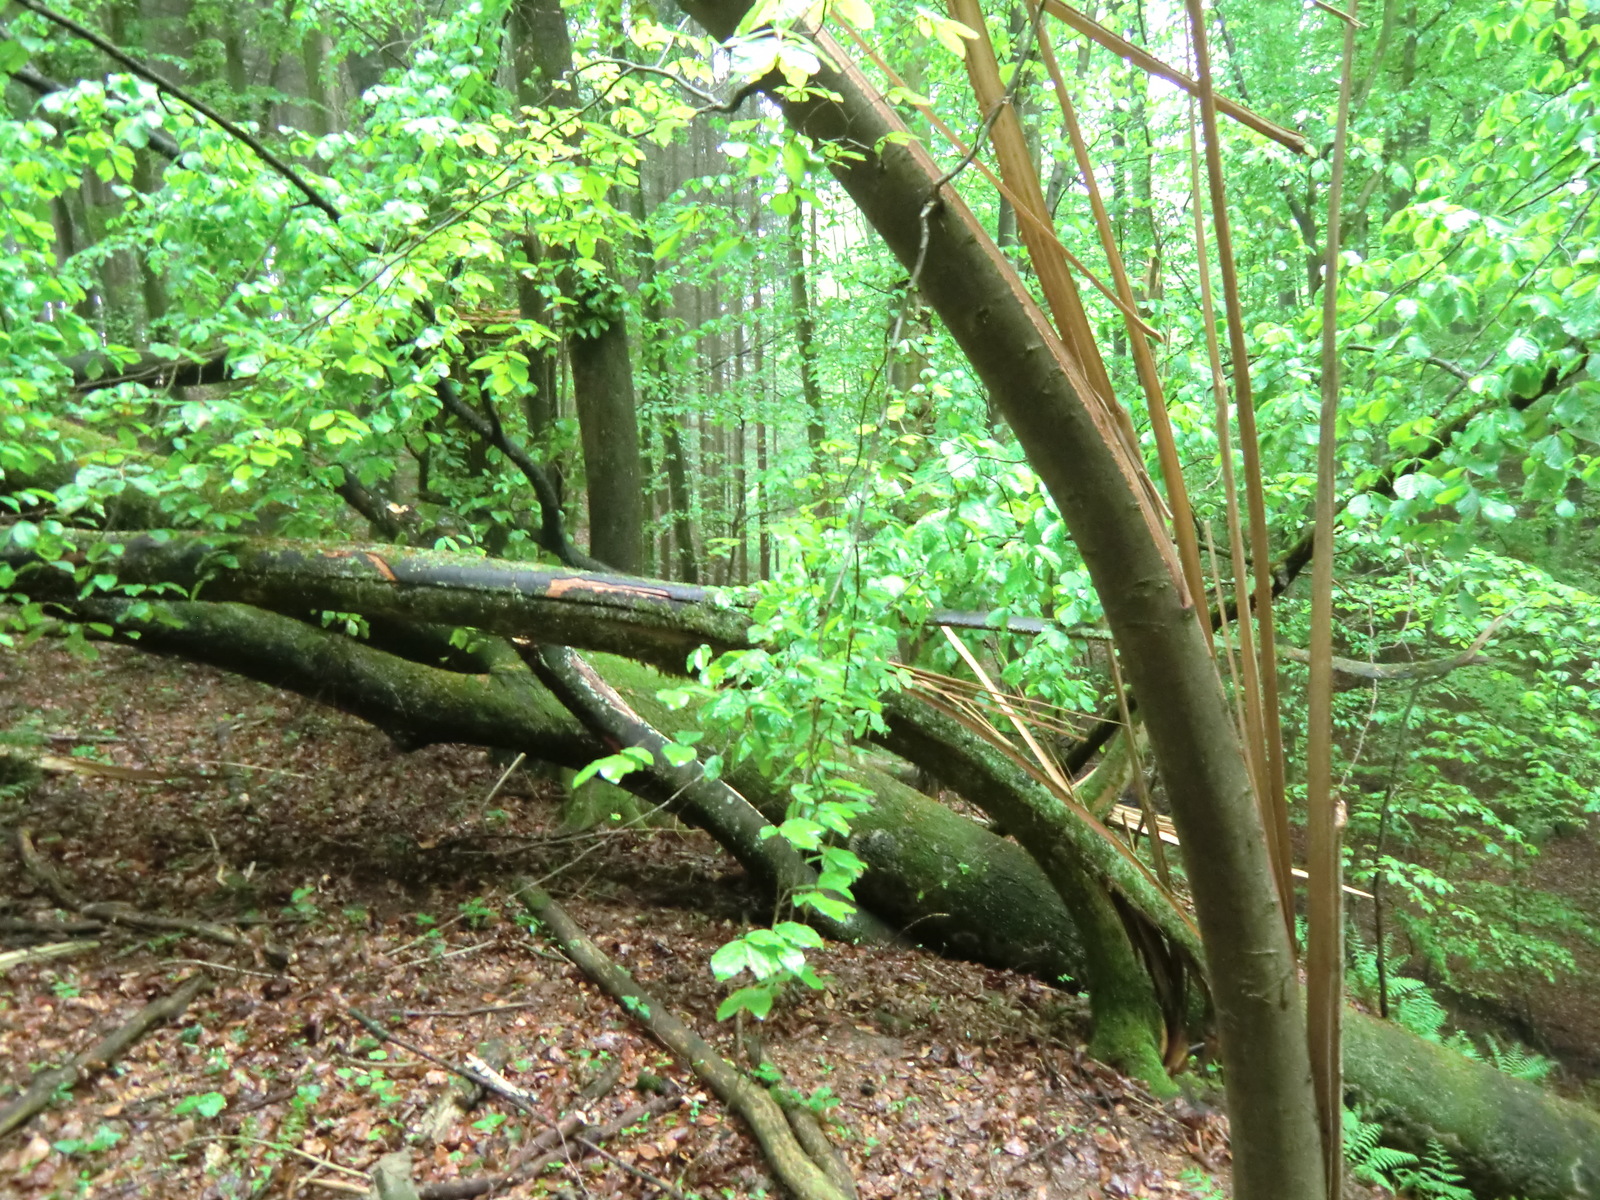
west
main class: Woodland
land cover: Broadleaved woodland
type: beech forest
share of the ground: > 75 %
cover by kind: broadleaved forest trees 80 %, unconsolidated bare surface 15 %, herbaceous plants 5 %
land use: Forestry
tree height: > 5 m
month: May
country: AT
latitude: 48.2292
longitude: 14.7529
